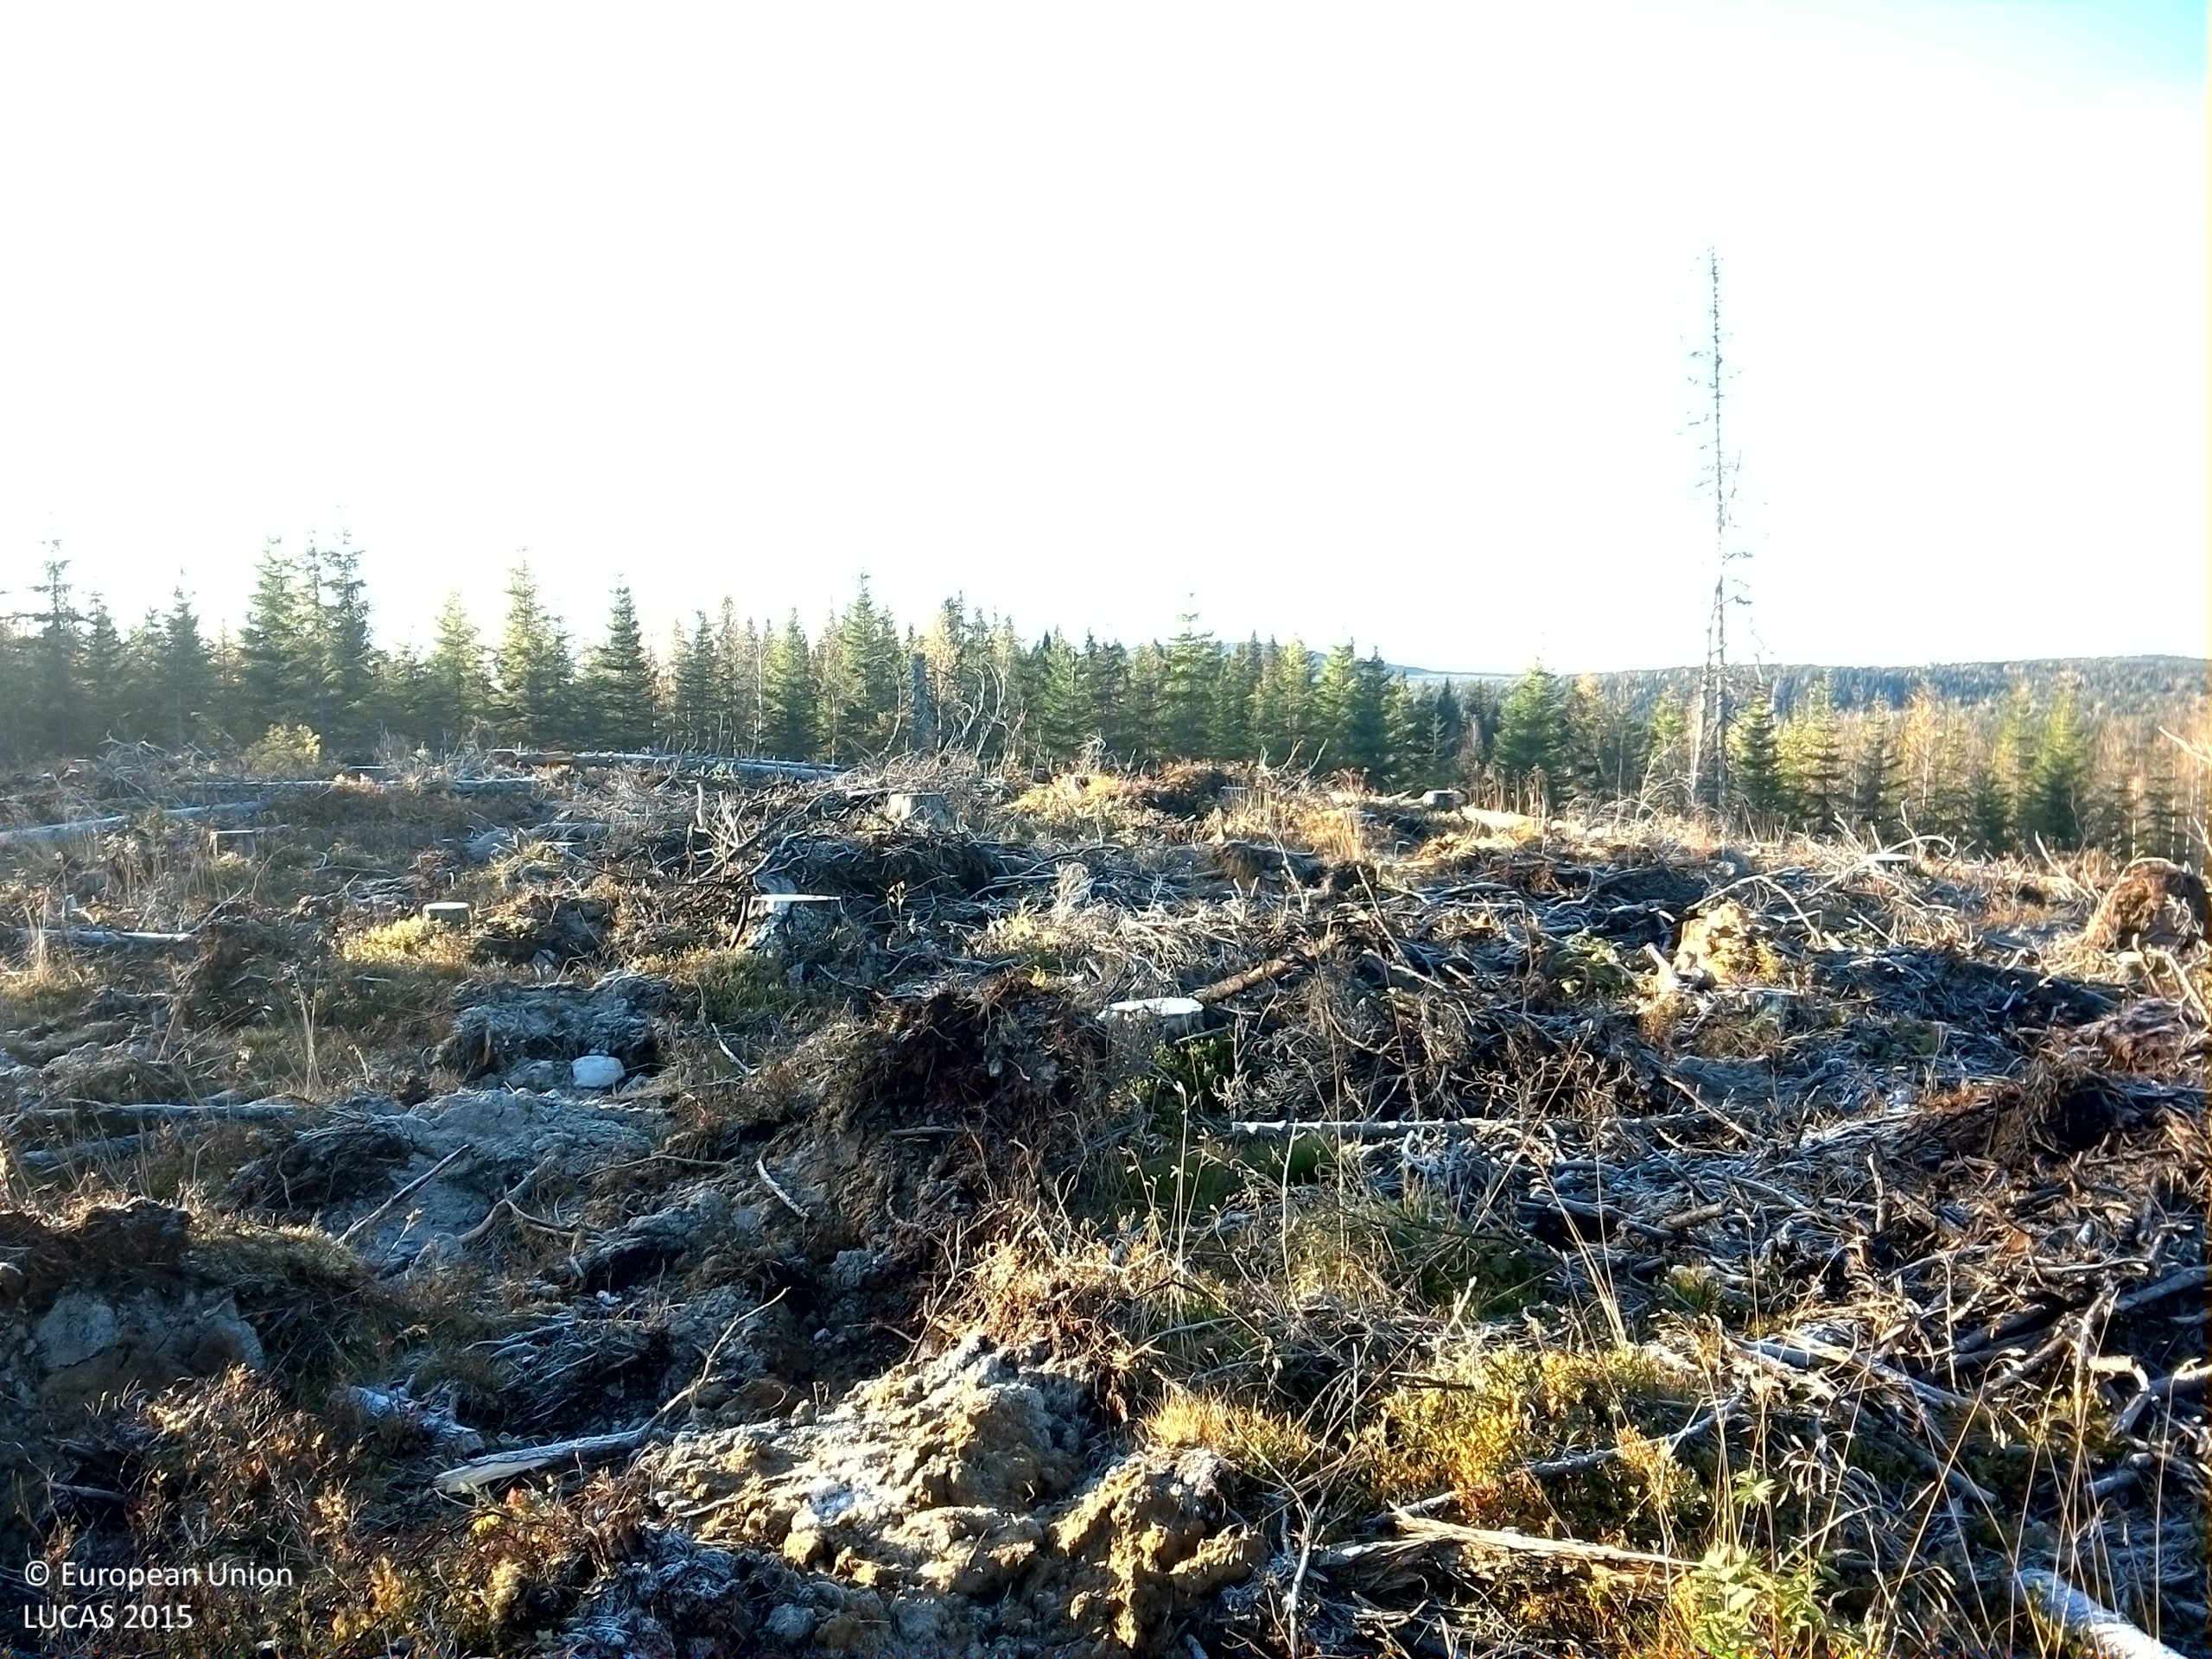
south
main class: Shrubland
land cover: Shrubland without tree cover
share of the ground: 25 - 50 %
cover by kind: shrubs 30 %, herbaceous plants 20 %, lichens and mosses 20 %, unconsolidated bare surface 10 %
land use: Forestry
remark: Clear cut
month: October
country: SE
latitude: 64.2839
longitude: 16.0221
